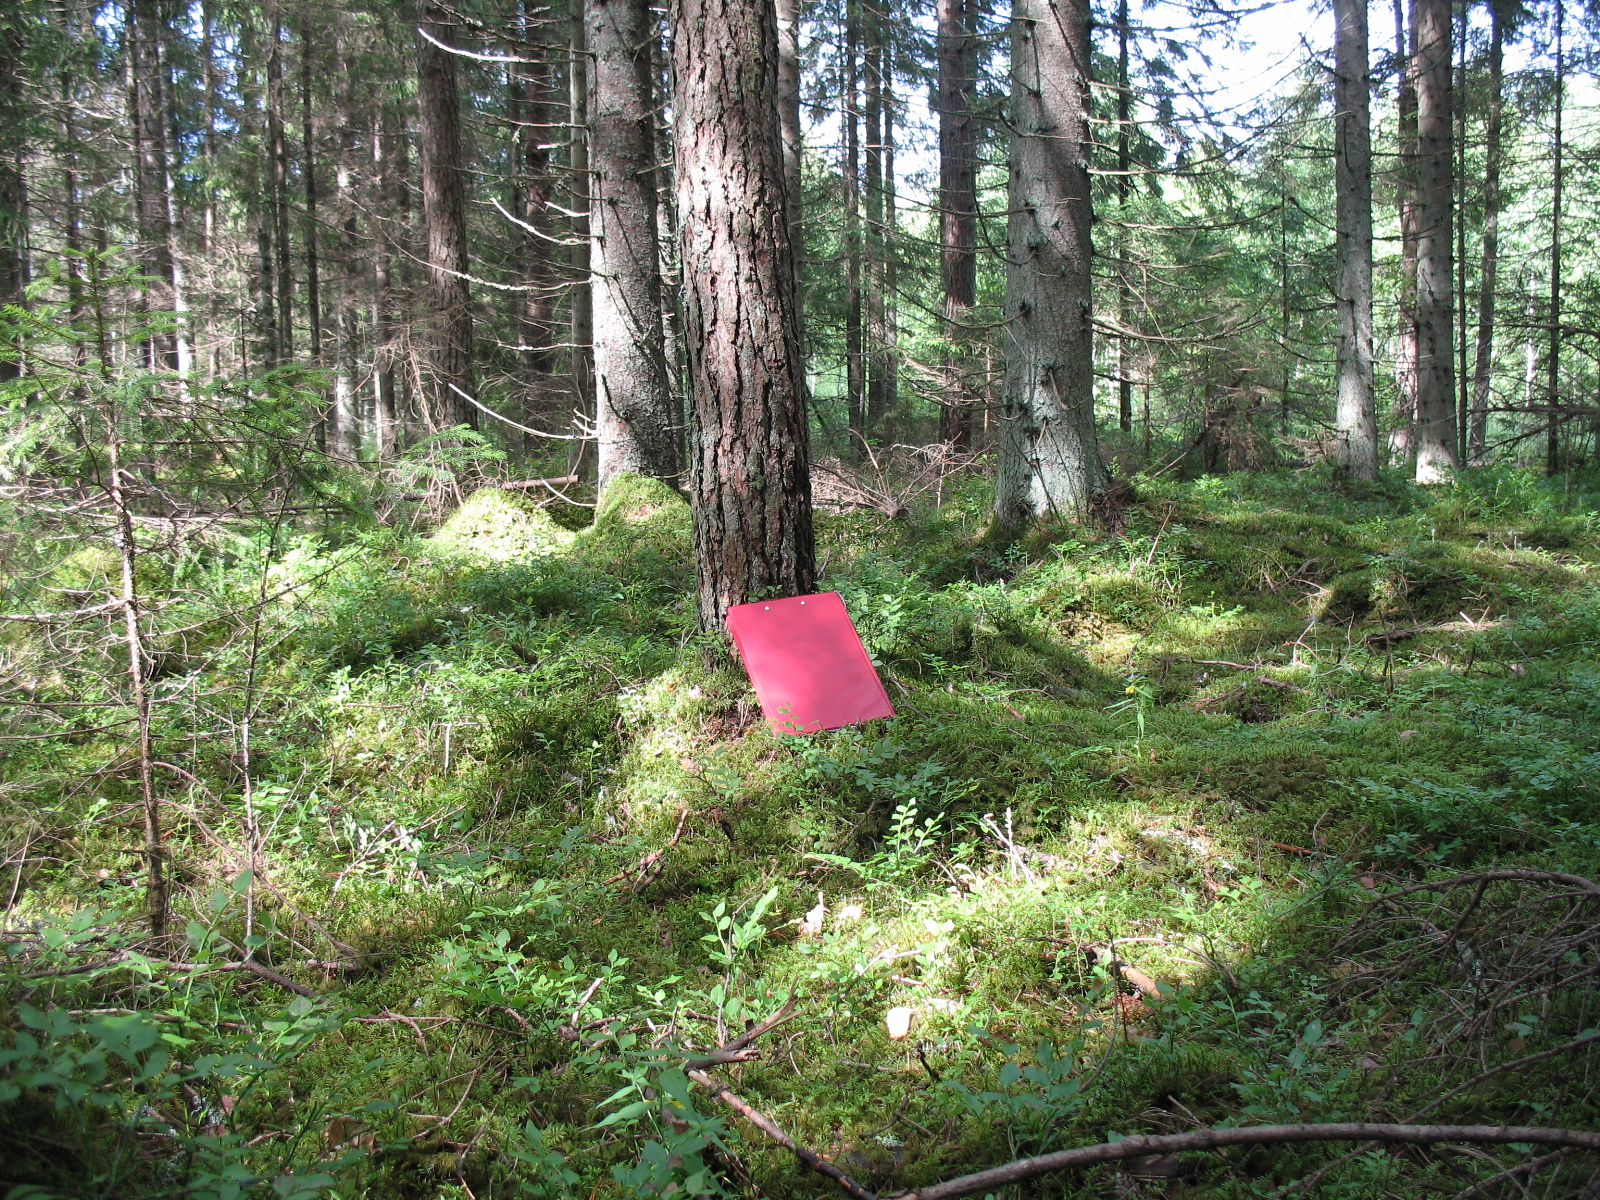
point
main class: Woodland
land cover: Other coniferous woodland
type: hemiboreal forest and nemoral coniferous forest and mixed broadleaved-coniferous forest
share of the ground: > 75 %
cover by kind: coniferous forest trees 85 %, lichens and mosses 10 %, herbaceous plants 5 %
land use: Forestry
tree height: > 5 m
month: July
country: LV
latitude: 56.5451
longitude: 25.1561
